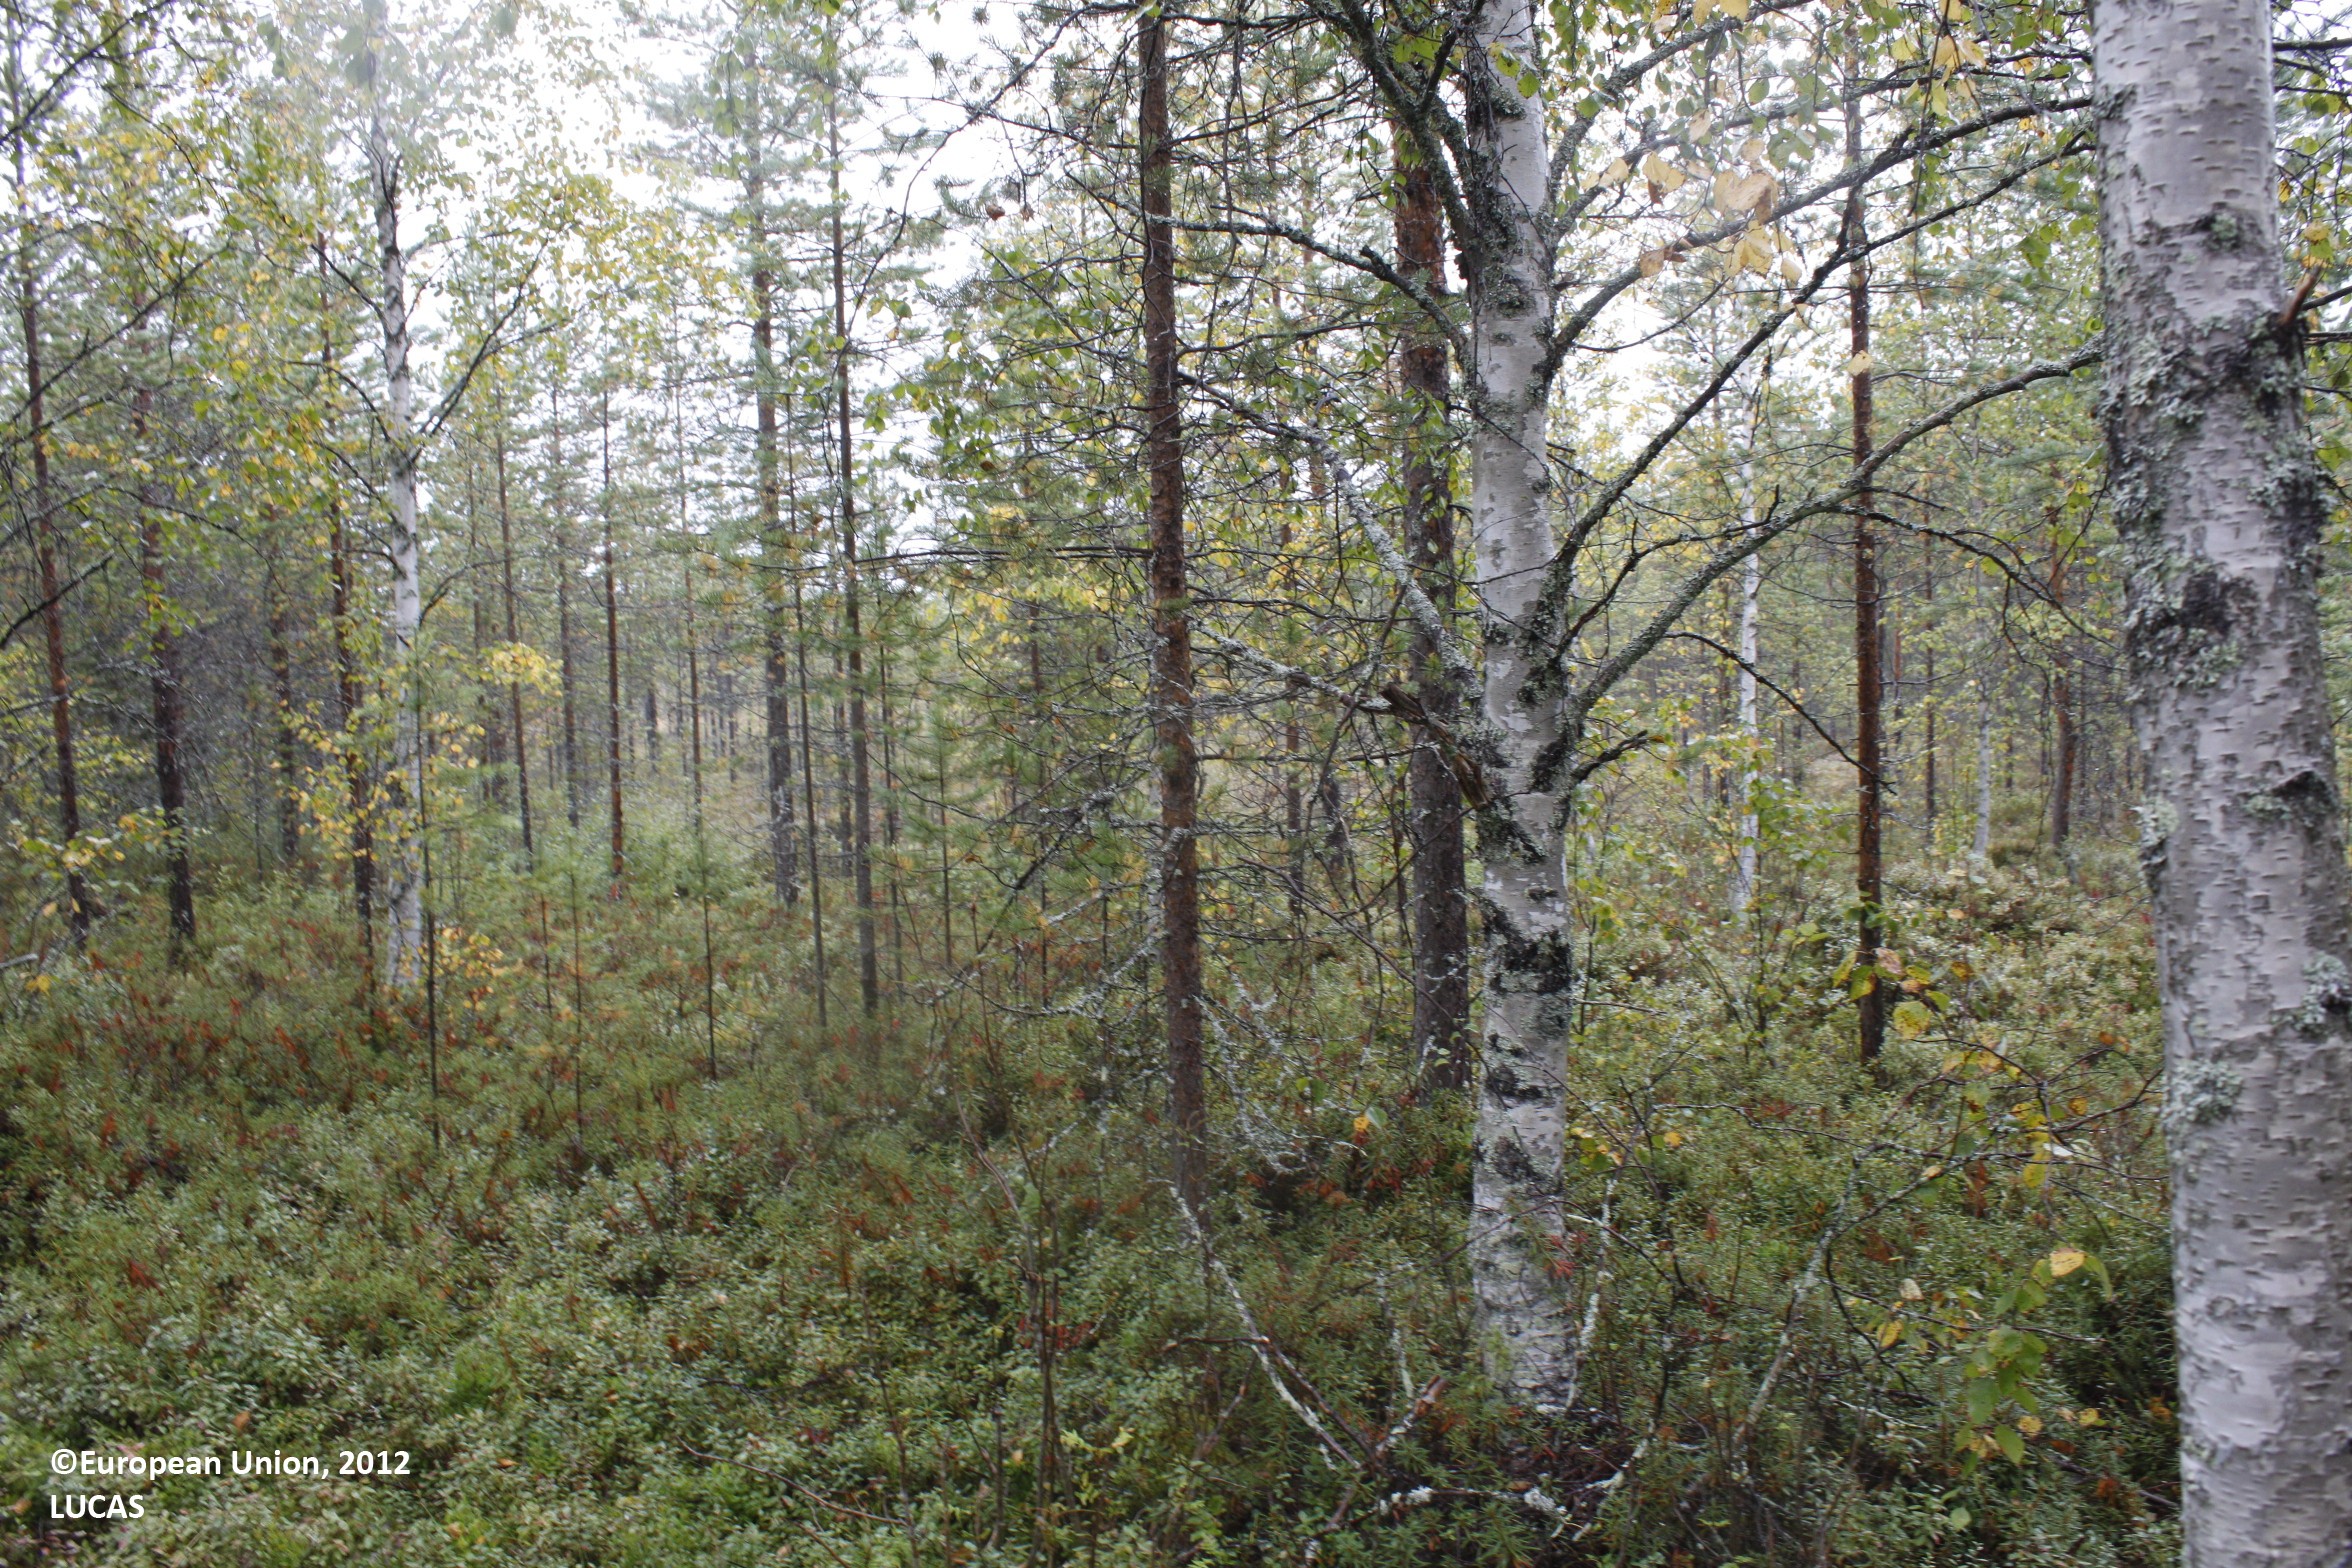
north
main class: Woodland
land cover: Pine dominated mixed woodland
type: mire and swamp forests
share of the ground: 25 - 50 %
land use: Forestry
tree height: > 5 m
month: September
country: FI
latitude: 65.3362
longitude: 26.9315
